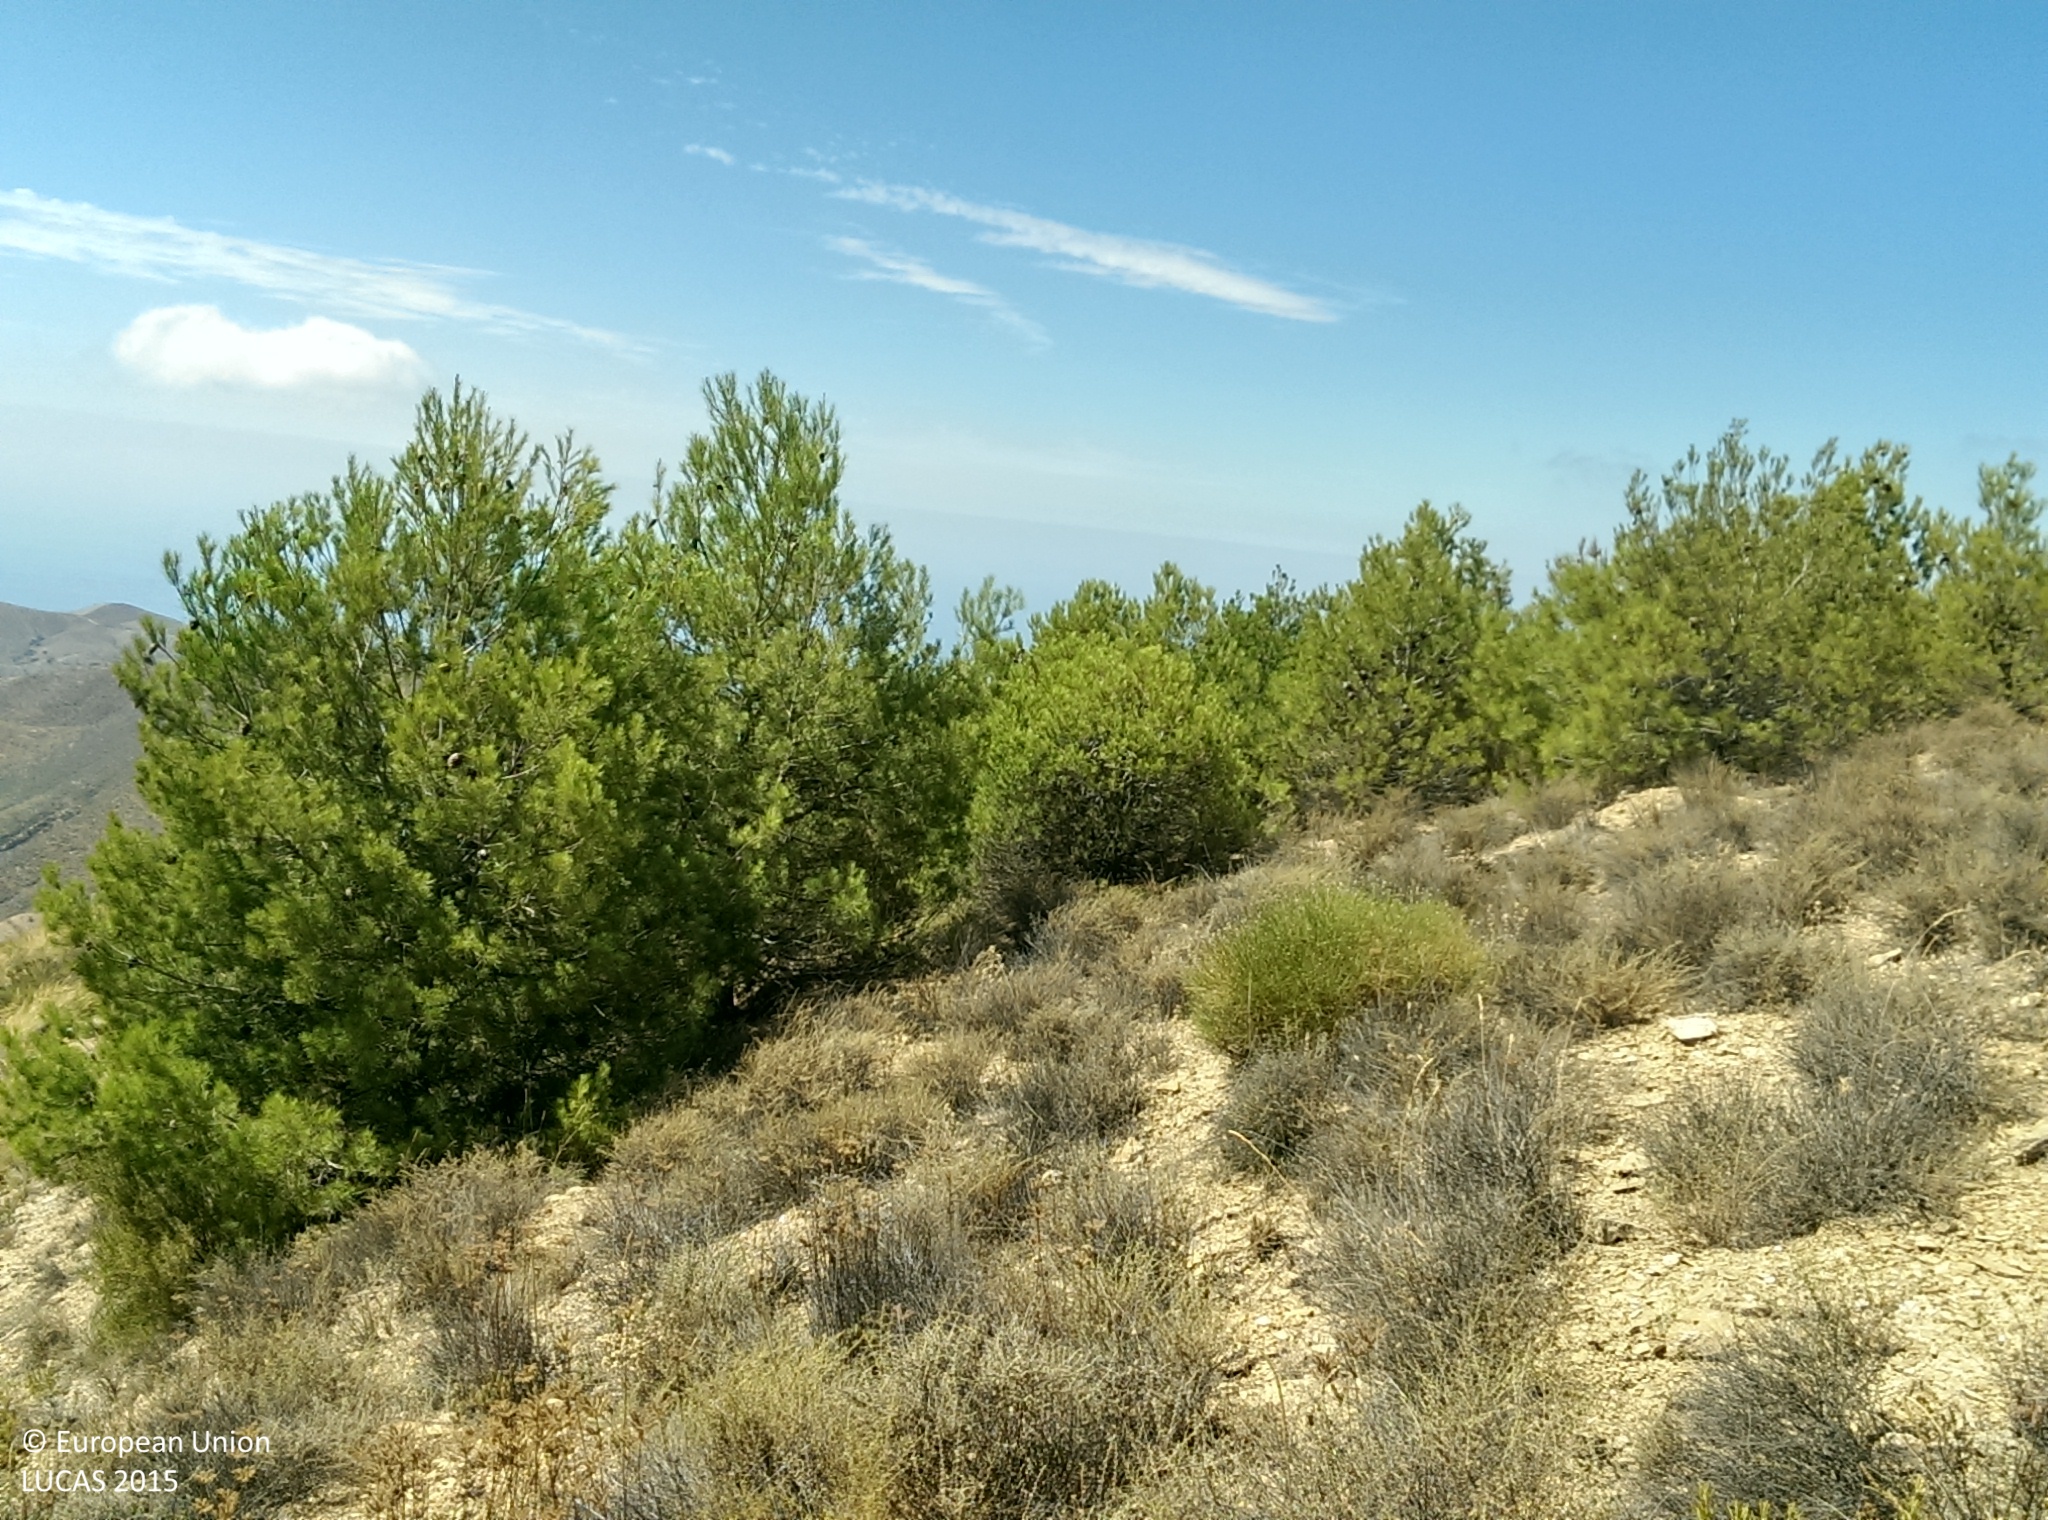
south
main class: Shrubland
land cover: Shrubland without tree cover
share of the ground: 50 - 75 %
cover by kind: shrubs 60 %, herbaceous plants 20 %, unconsolidated bare surface 20 %
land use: Semi-natural and natural areas not in use
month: August
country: ES
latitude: 36.8178
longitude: -3.1065
